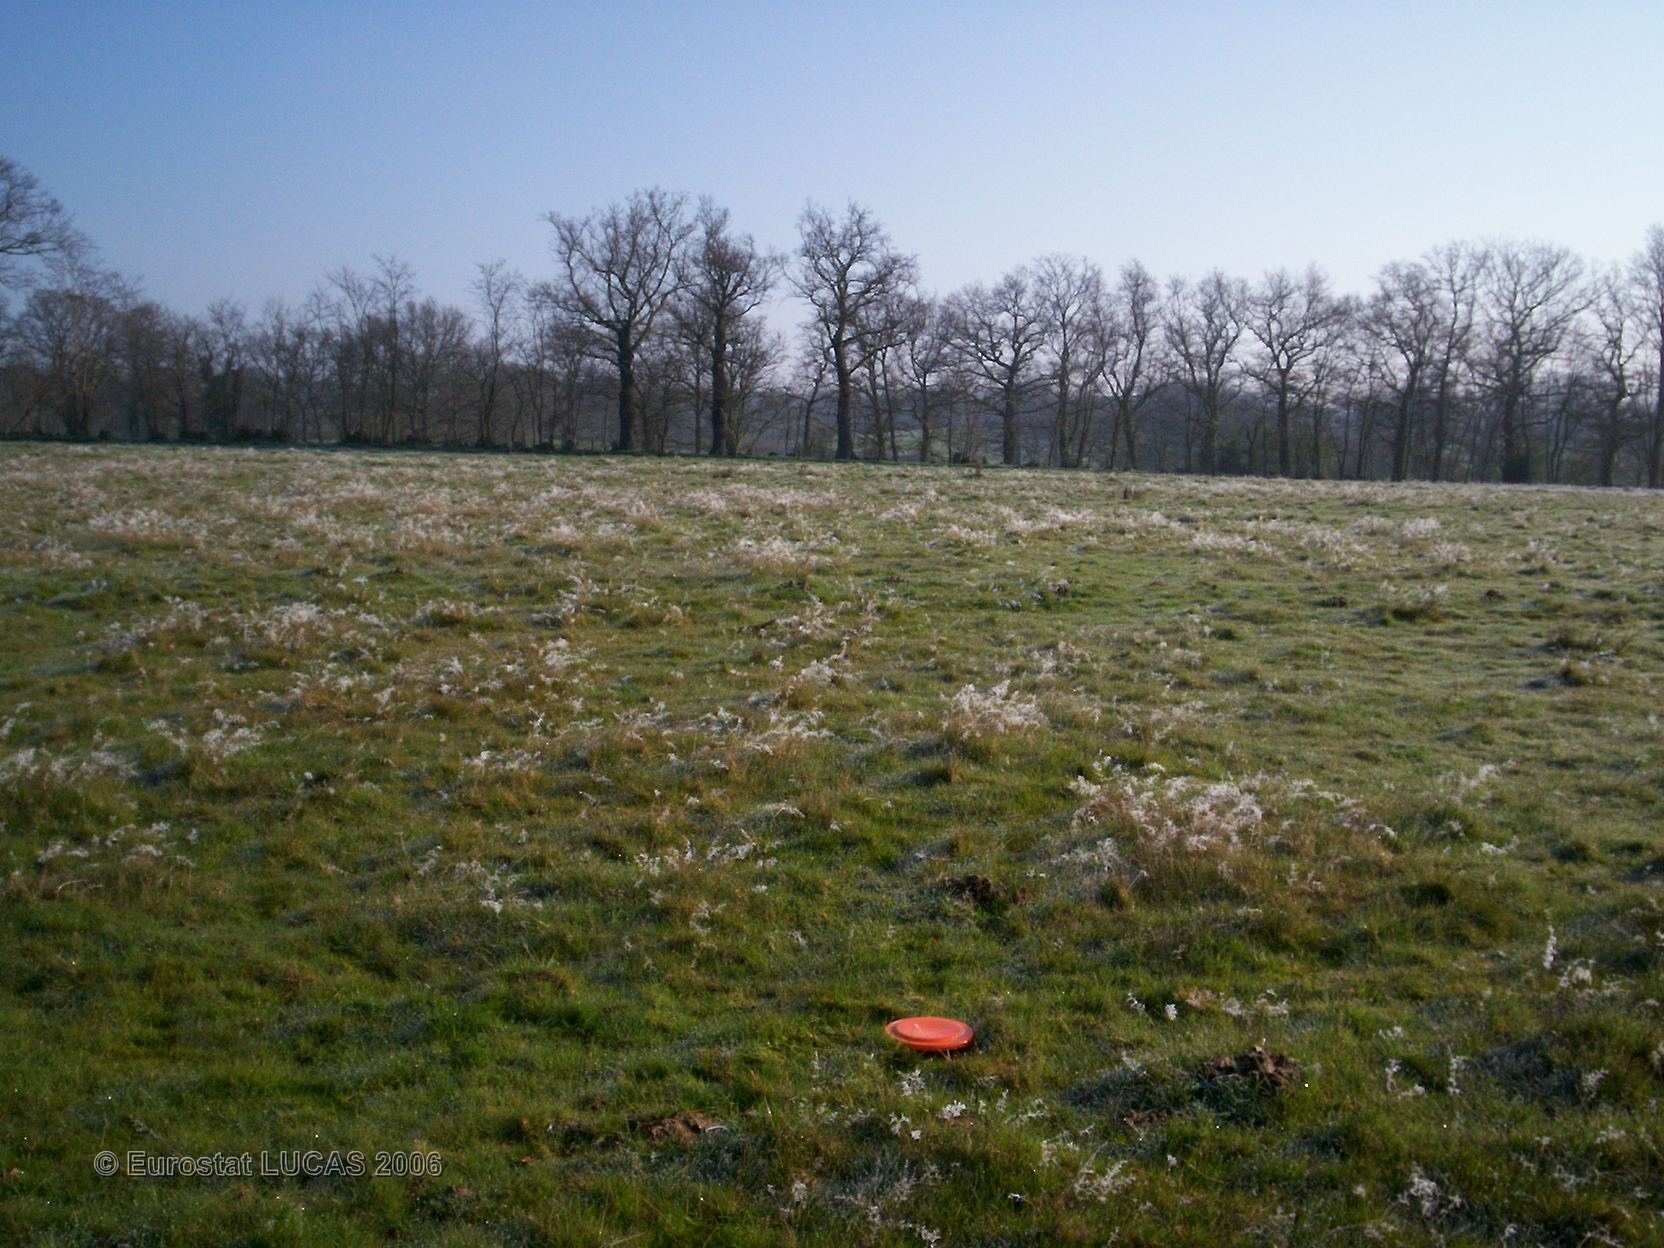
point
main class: Grassland
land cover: Grassland without tree/shrub cover
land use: Agriculture (excluding fallow land and kitchen gardens)
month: April
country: FR
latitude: 46.2516
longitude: 1.1027
